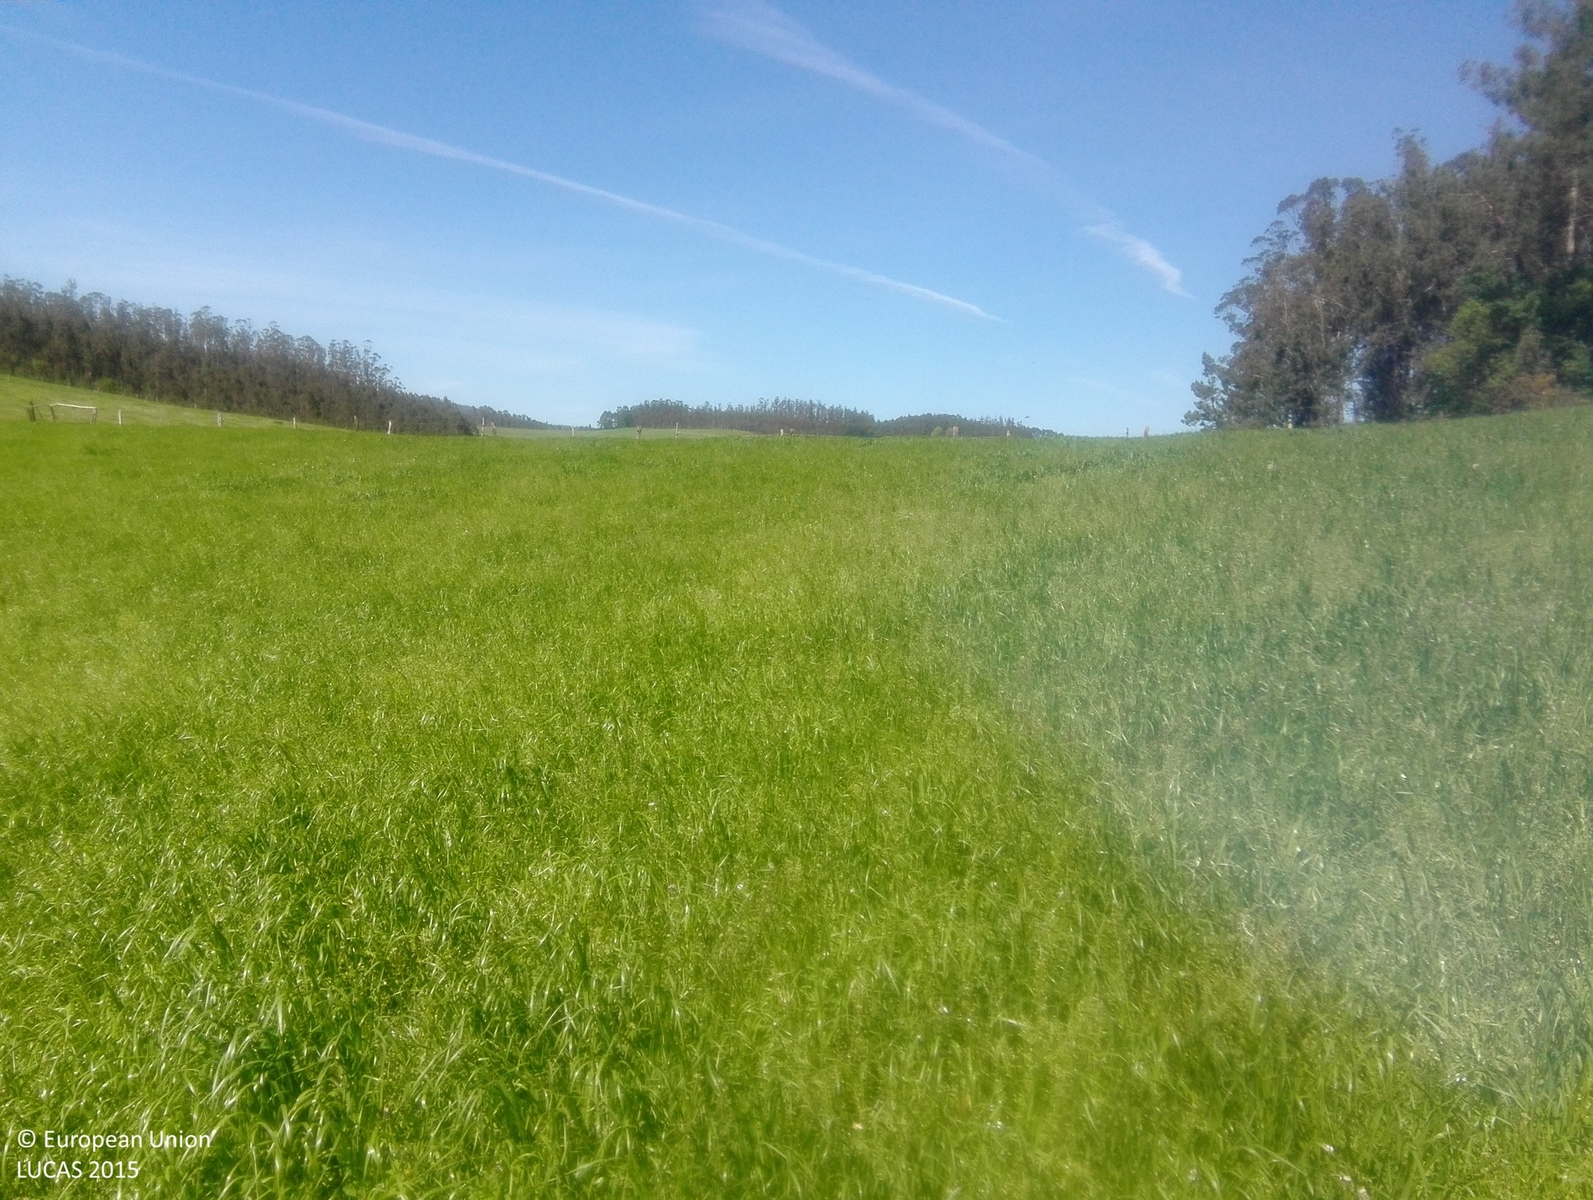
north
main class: Cropland
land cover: Temporary grasslands
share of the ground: > 75 %
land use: Agriculture (excluding fallow land and kitchen gardens)
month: April
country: ES
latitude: 43.4759
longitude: -7.0680
